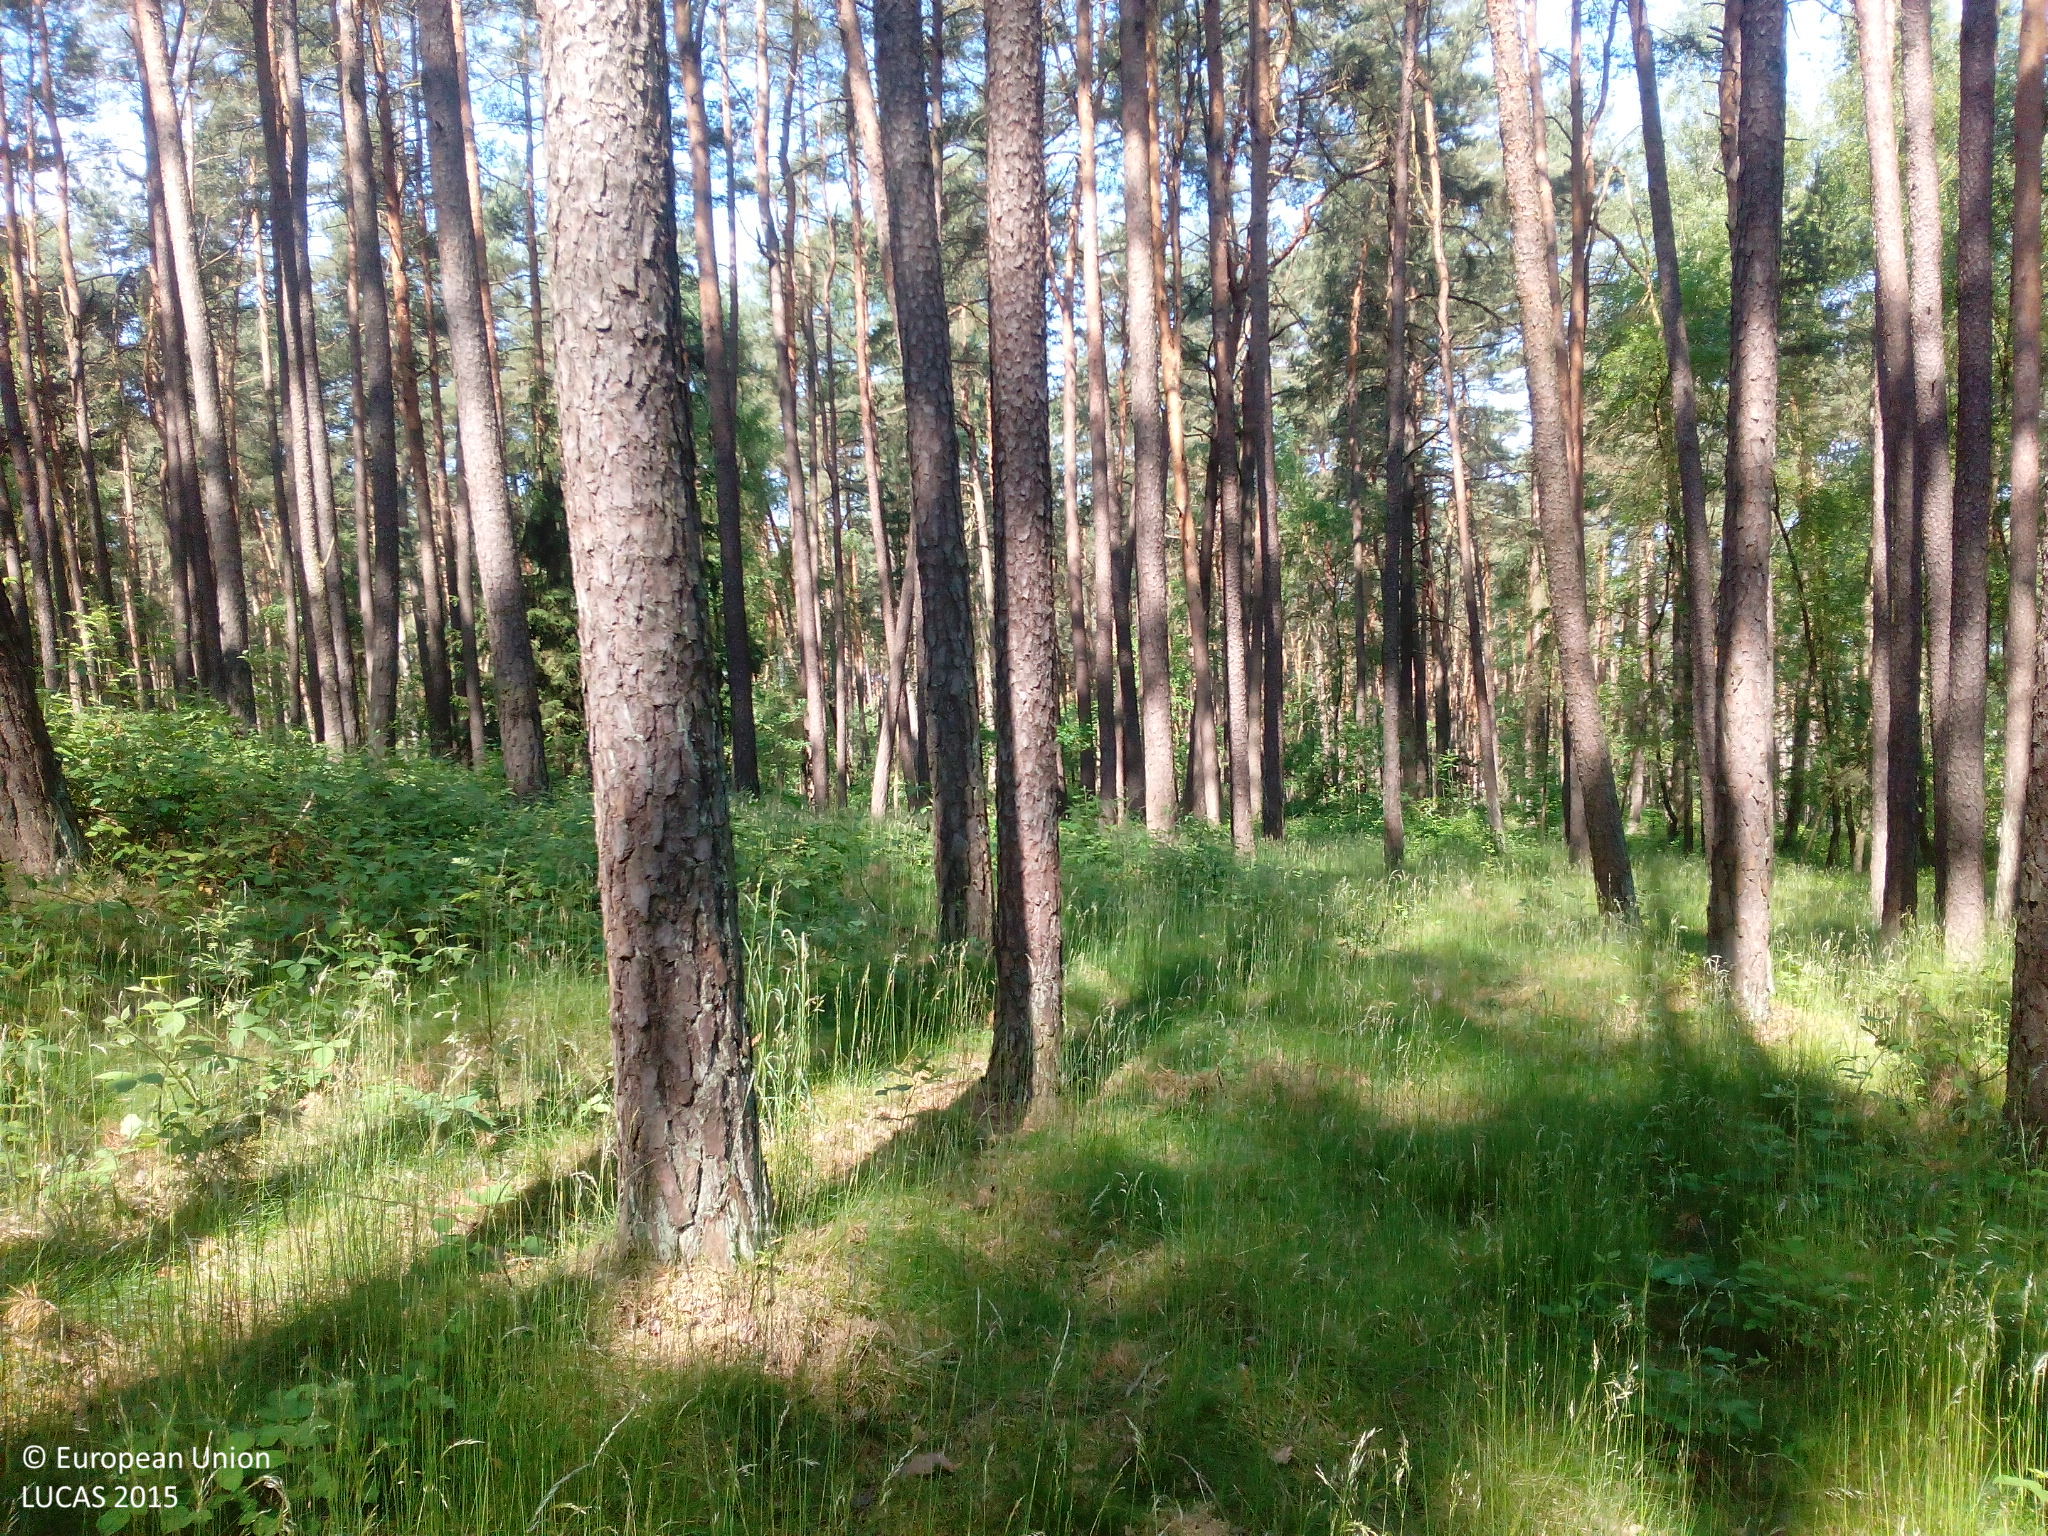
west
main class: Woodland
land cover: Pine dominated coniferous woodland
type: hemiboreal forest and nemoral coniferous forest and mixed broadleaved-coniferous forest
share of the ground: > 75 %
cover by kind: coniferous forest trees 75 %, herbaceous plants 15 %, shrubs 10 %
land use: Forestry
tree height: > 5 m
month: June
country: DE
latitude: 49.3711
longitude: 12.2167
